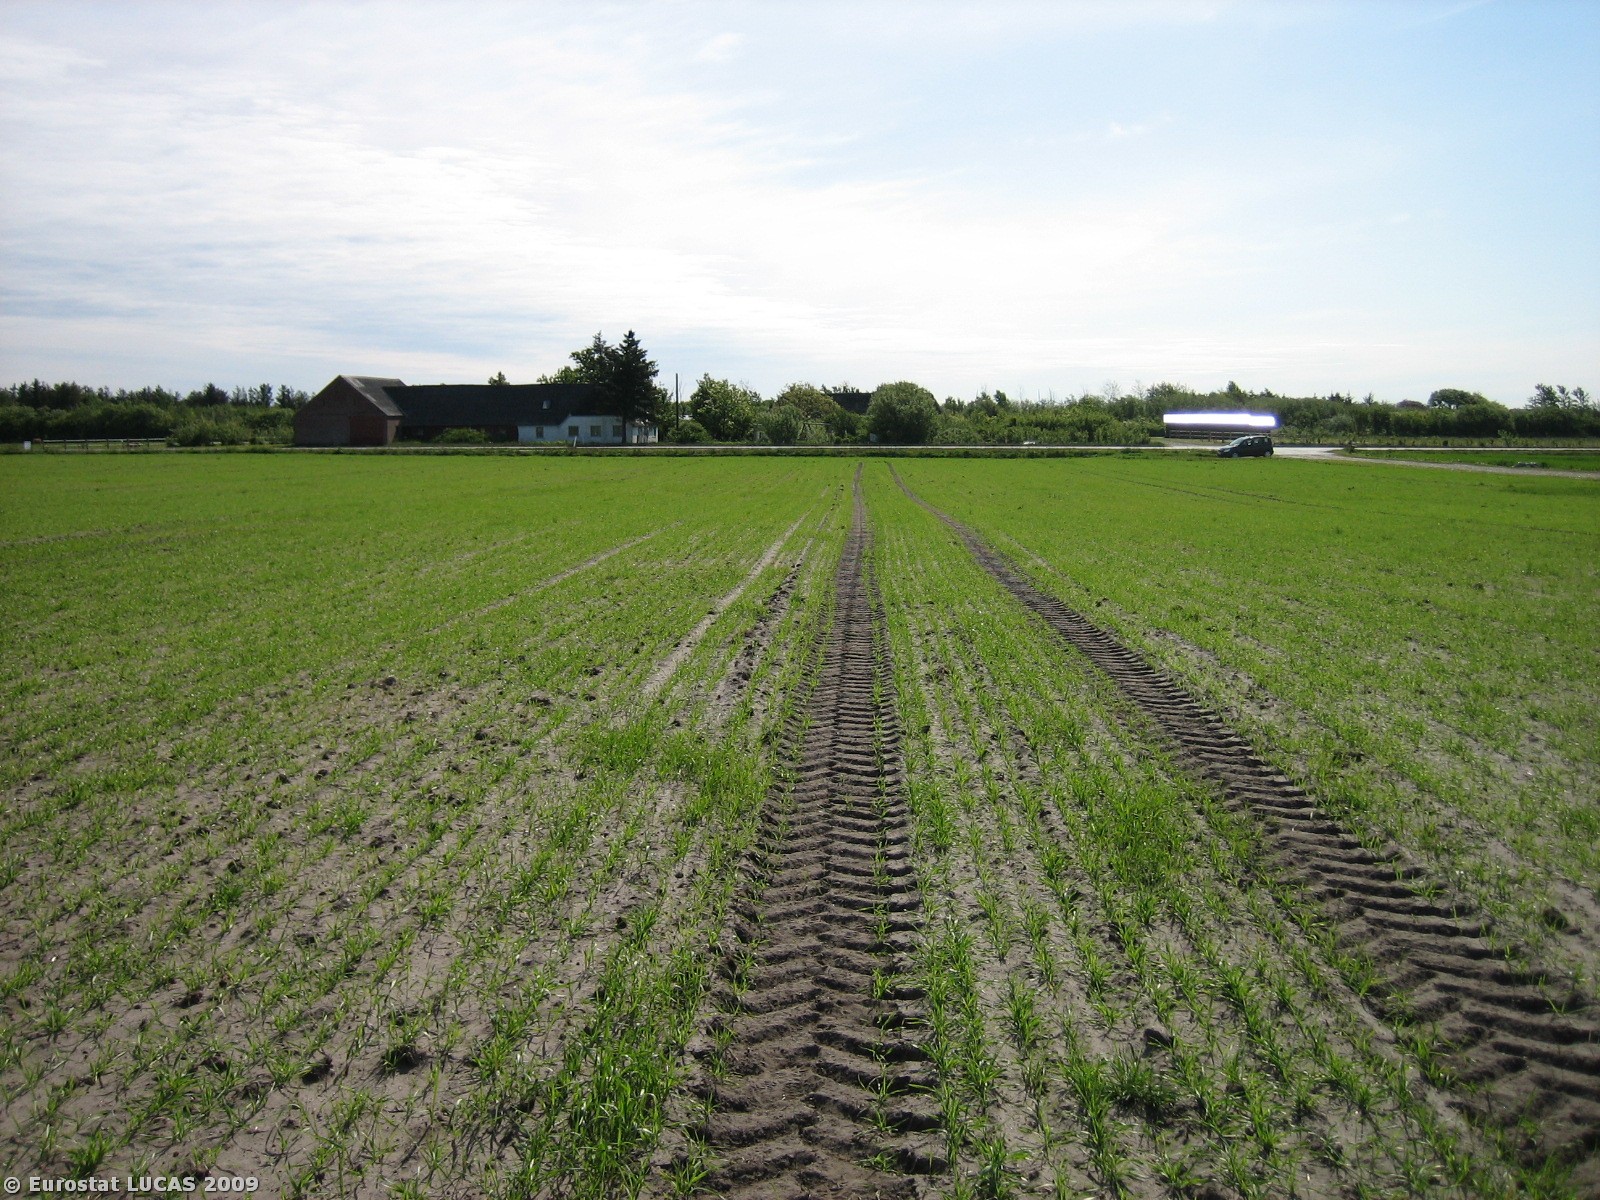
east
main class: Cropland
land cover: Barley
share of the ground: 50 - 75 %
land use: Agriculture (excluding fallow land and kitchen gardens)
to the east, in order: Barley; Grass margins; Ditches and canals; Grass margins; Paved roads, cycling and walking lanes; Grassland without tree/shrub cover; Artificial constructions in urban areas; Shruby margins; Broadleaved woodland; Grass margins; Artificial constructions in urban areas
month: May
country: DK
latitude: 56.1403
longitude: 8.2799
